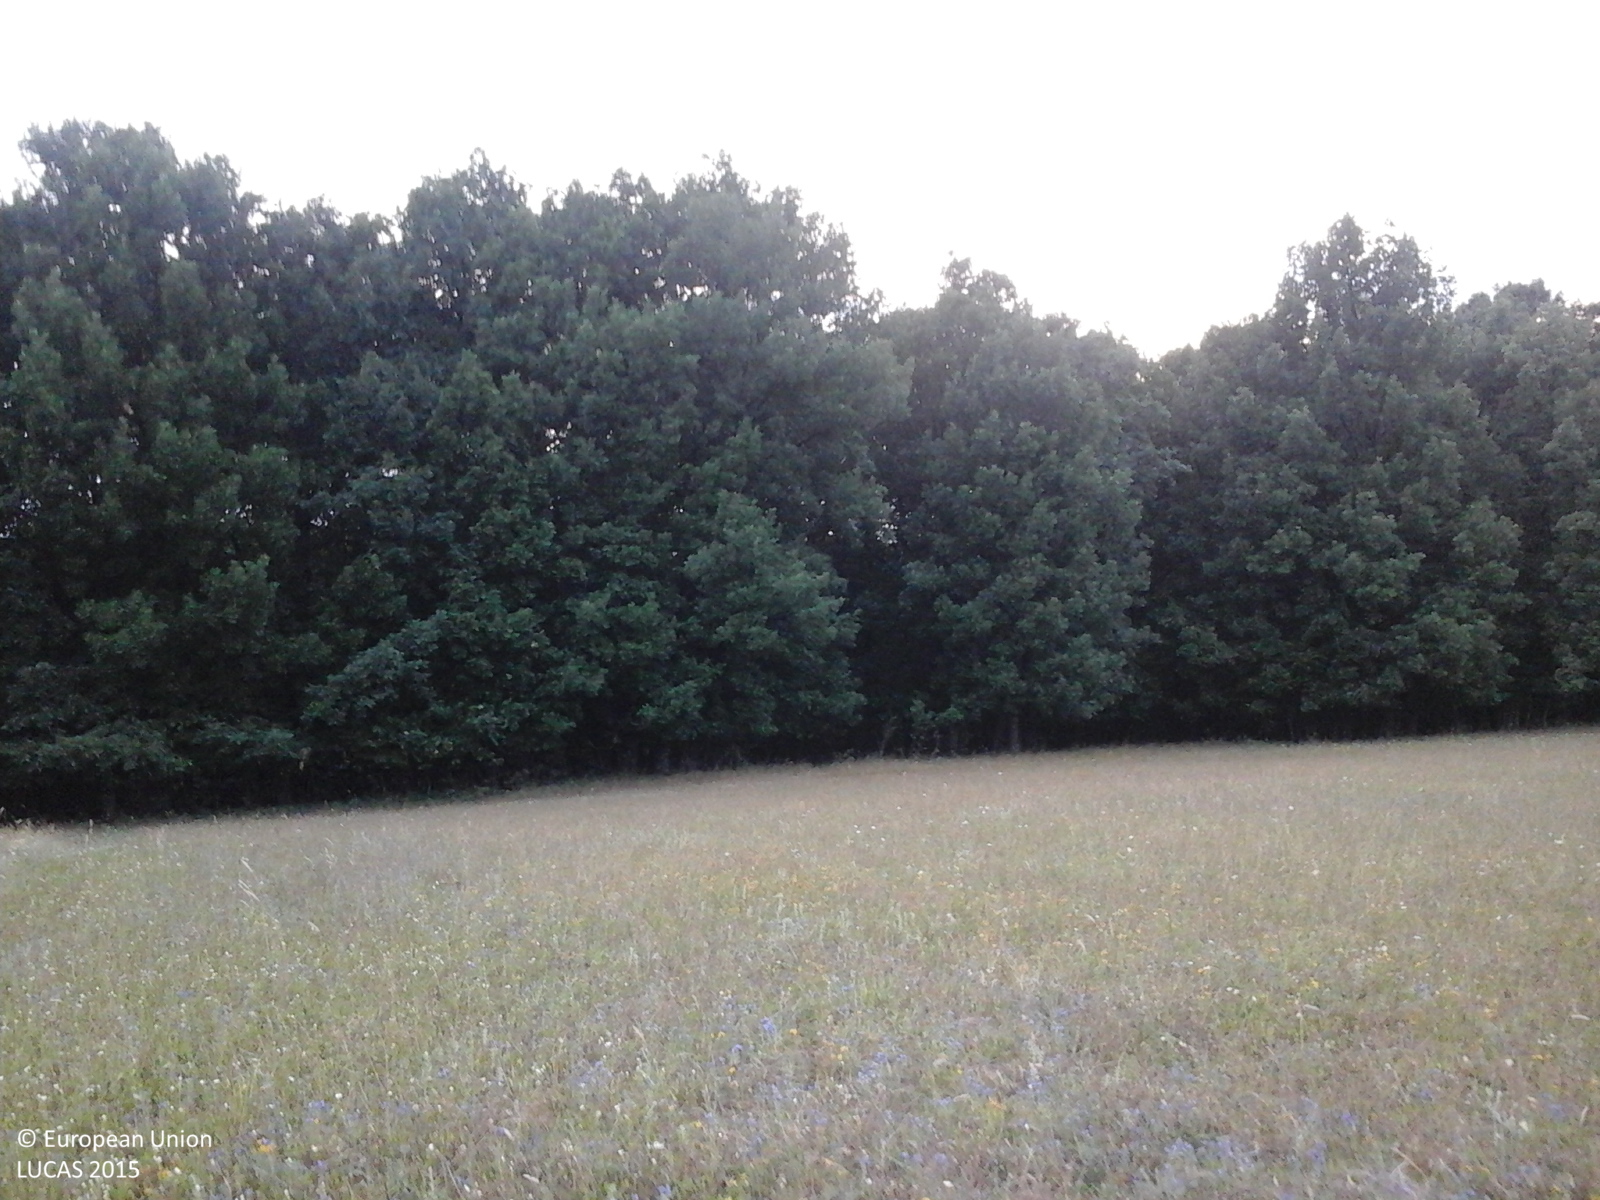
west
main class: Grassland
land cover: Grassland without tree/shrub cover
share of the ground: > 75 %
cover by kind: herbaceous plants 100 %
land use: Agriculture (excluding fallow land and kitchen gardens)
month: July
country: RO
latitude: 44.9103
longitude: 24.5531
